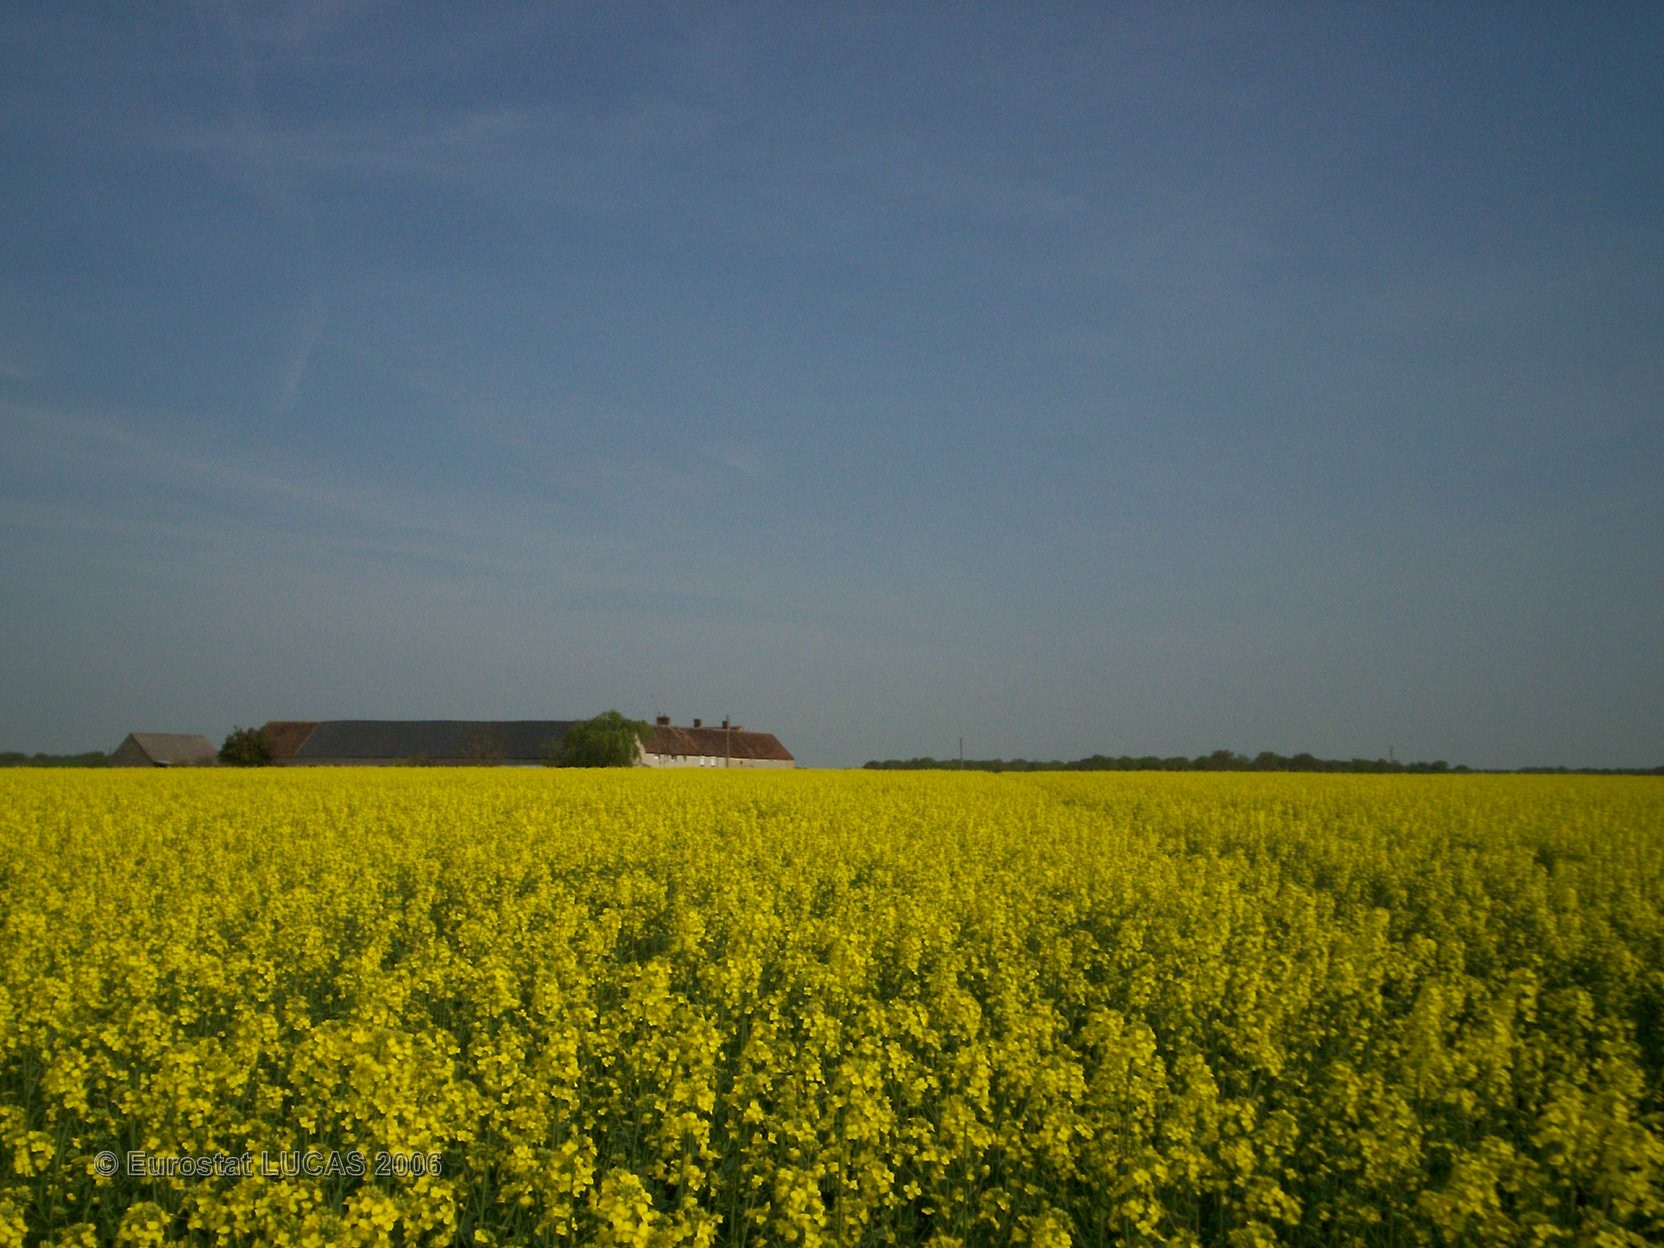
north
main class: Cropland
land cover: Rape and turnip rape
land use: Agriculture (excluding fallow land and kitchen gardens)
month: May
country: FR
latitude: 48.0859
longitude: 2.9175
